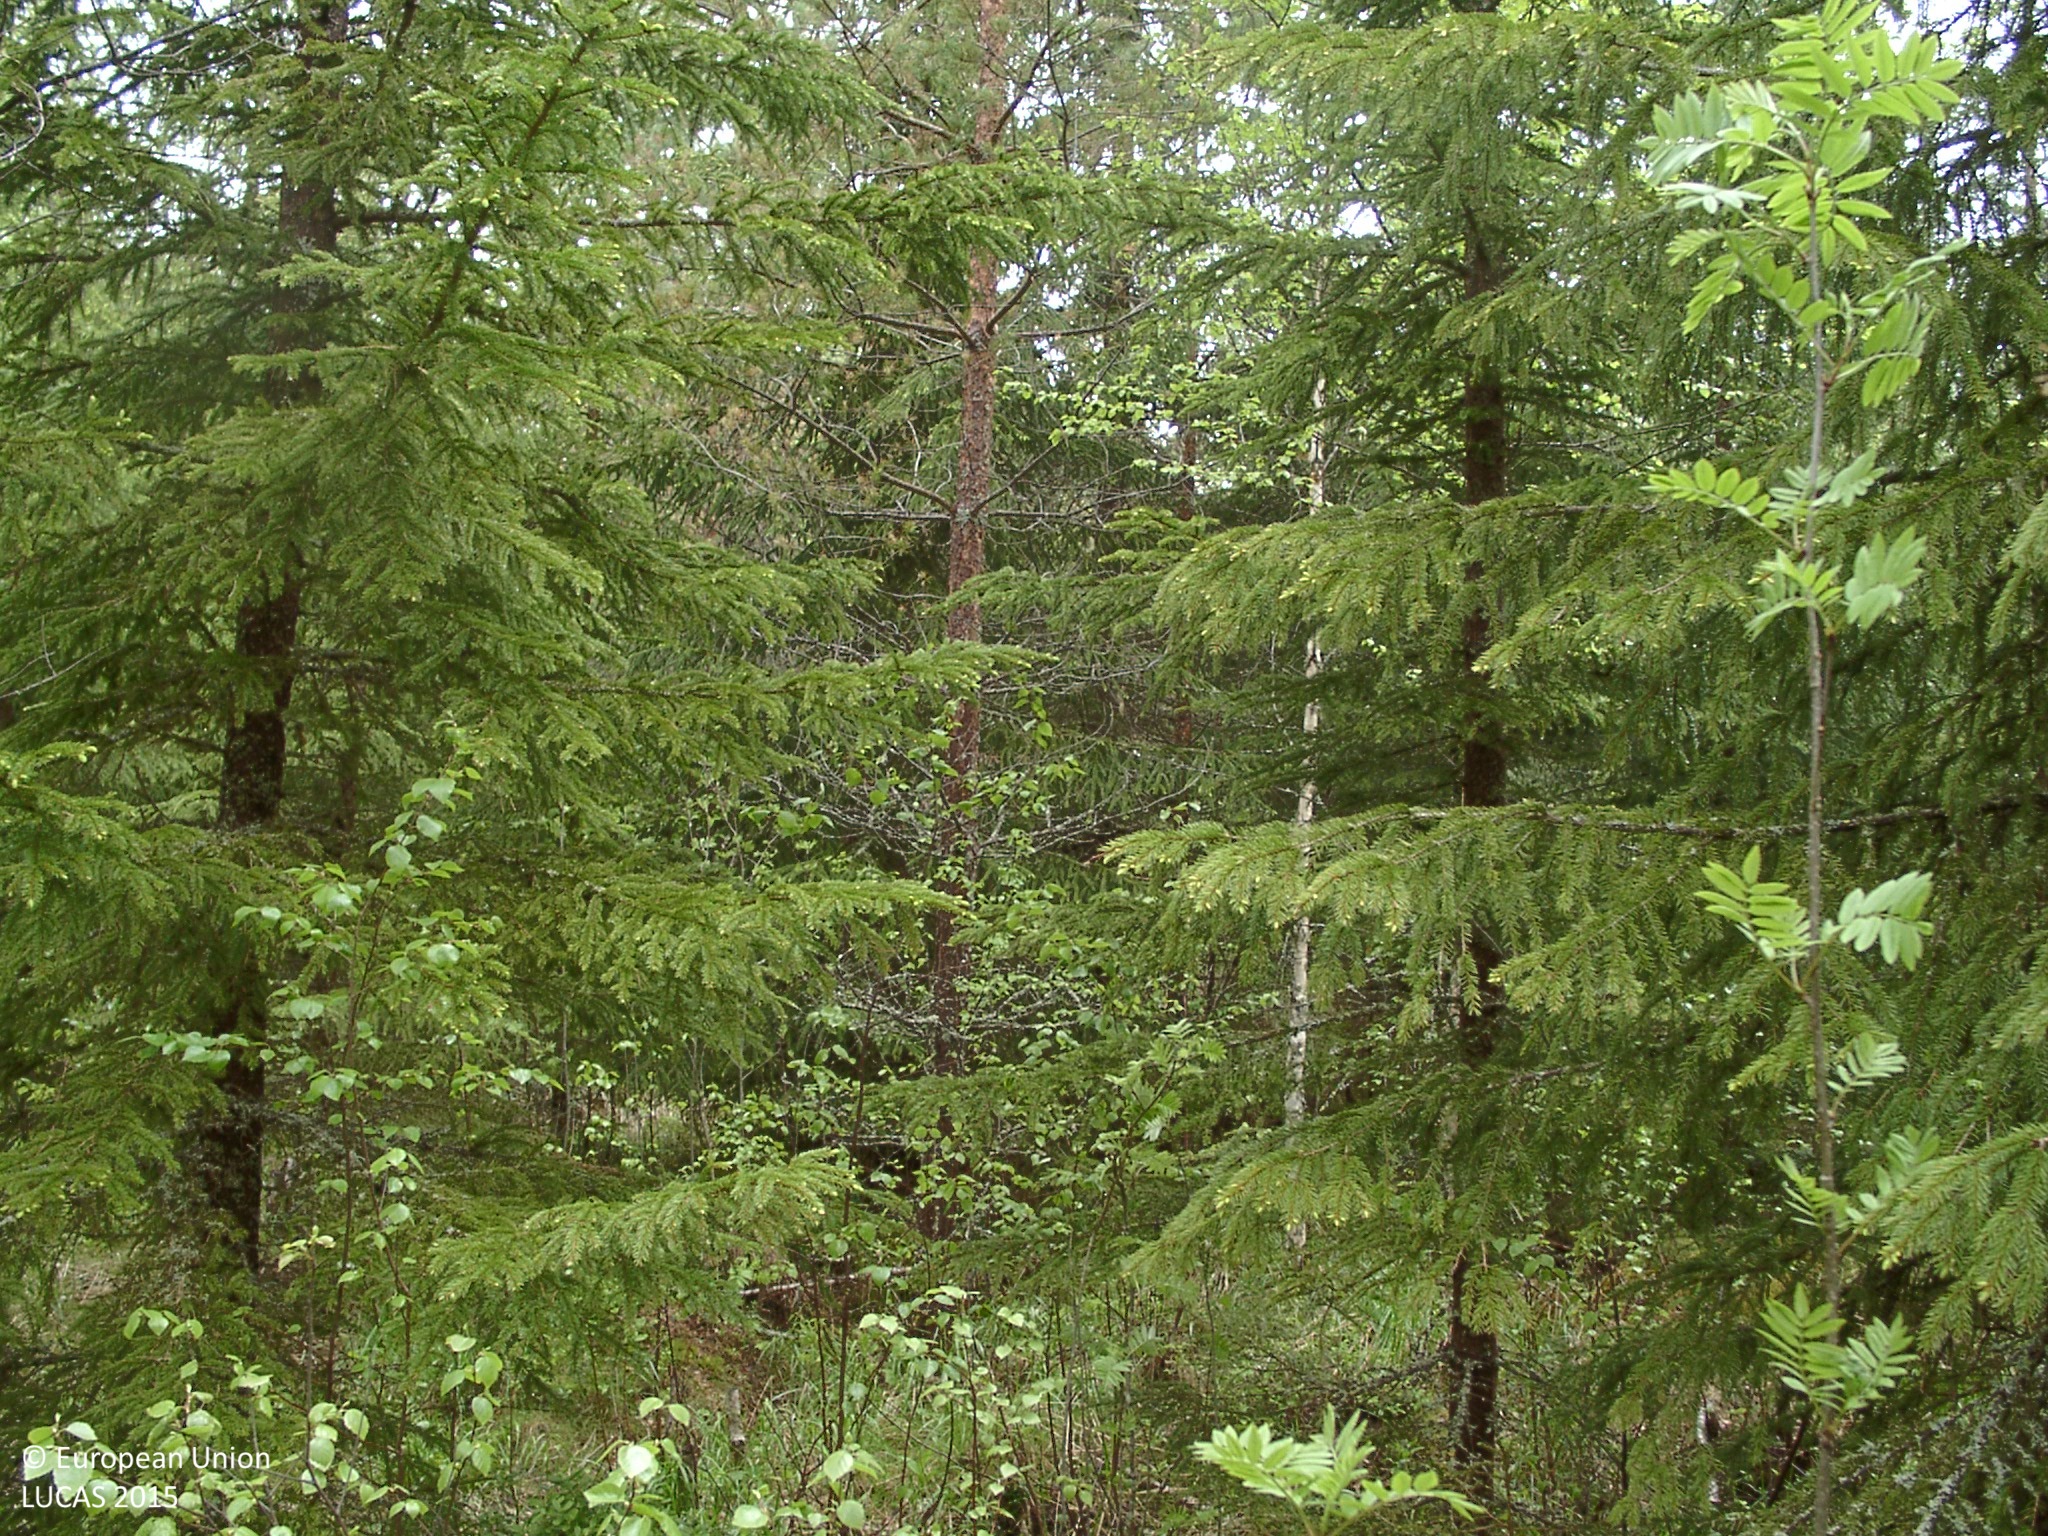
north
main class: Woodland
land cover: Spruce dominated mixed woodland
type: boreal forest
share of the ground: 50 - 75 %
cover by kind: coniferous forest trees 45 %, herbaceous plants 25 %, broadleaved forest trees 20 %, shrubs 5 %, lichens and mosses 5 %
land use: Forestry
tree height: > 5 m
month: June
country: FI
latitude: 62.2163
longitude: 25.5972
